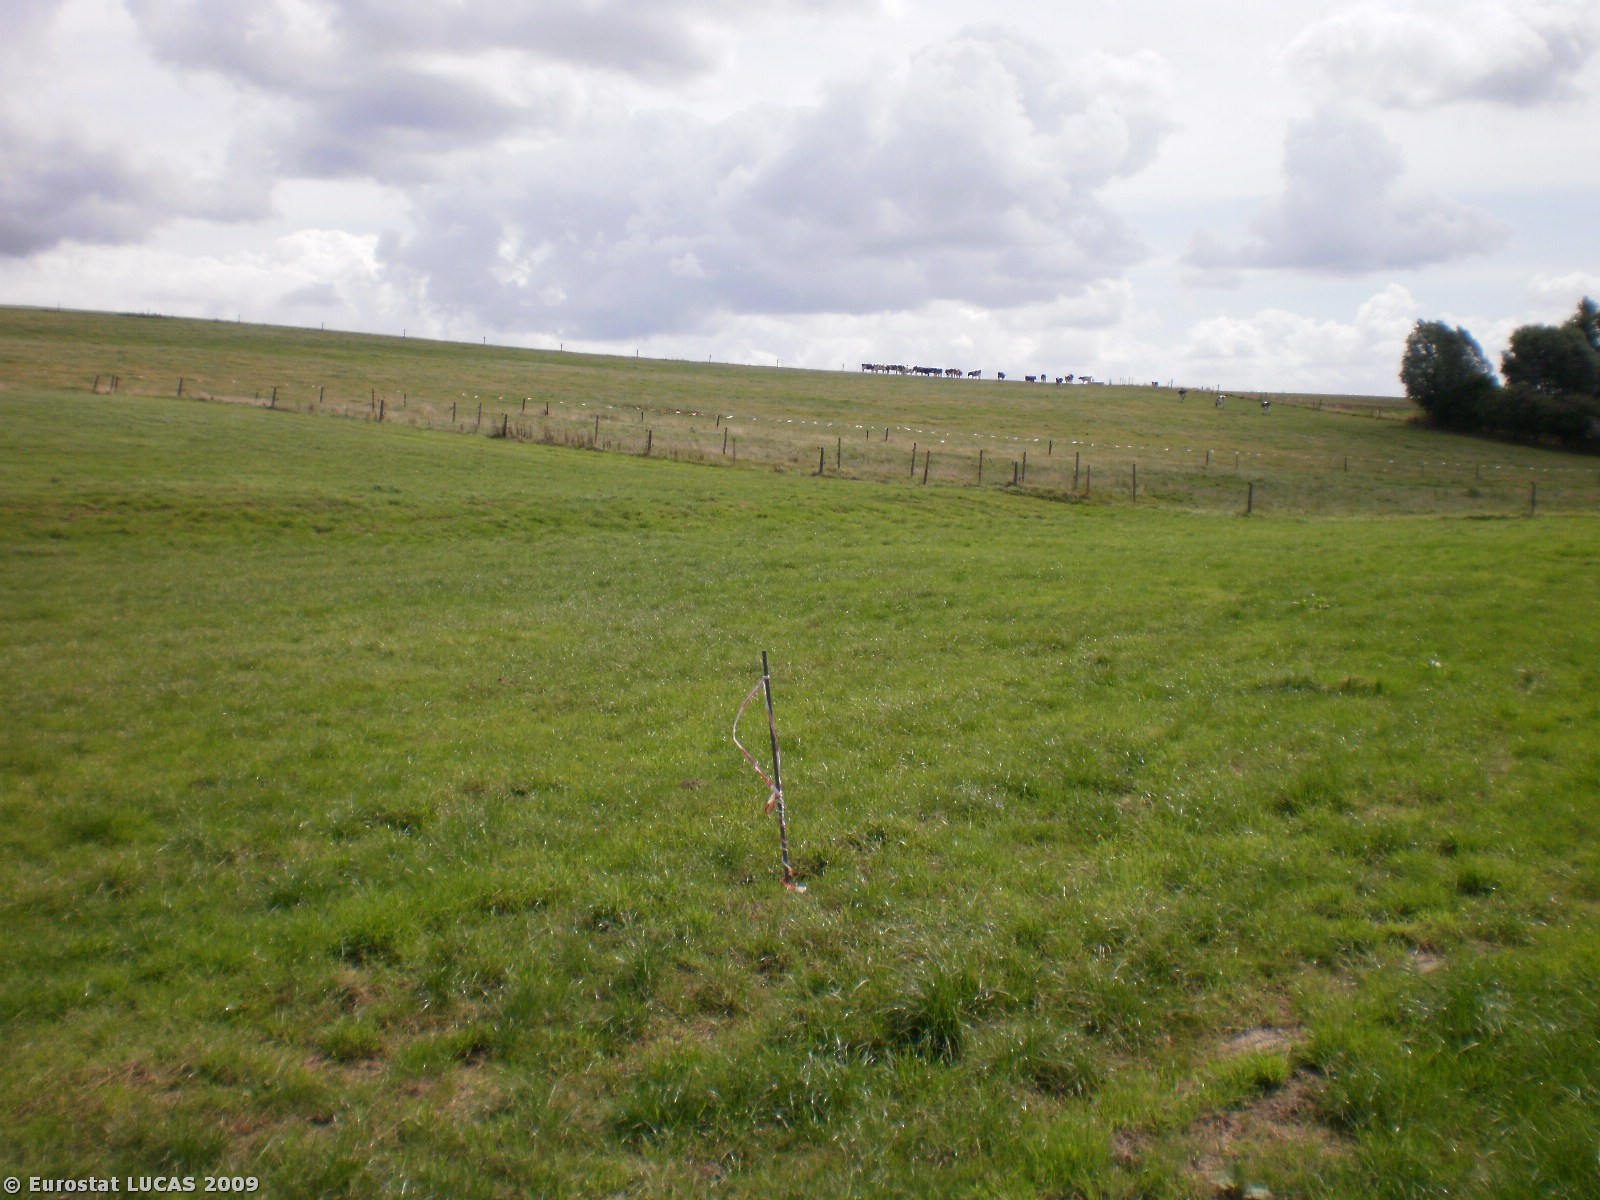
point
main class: Grassland
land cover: Grassland without tree/shrub cover
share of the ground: > 75 %
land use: Agriculture (excluding fallow land and kitchen gardens)
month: July
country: BE
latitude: 50.7671
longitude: 2.7718
